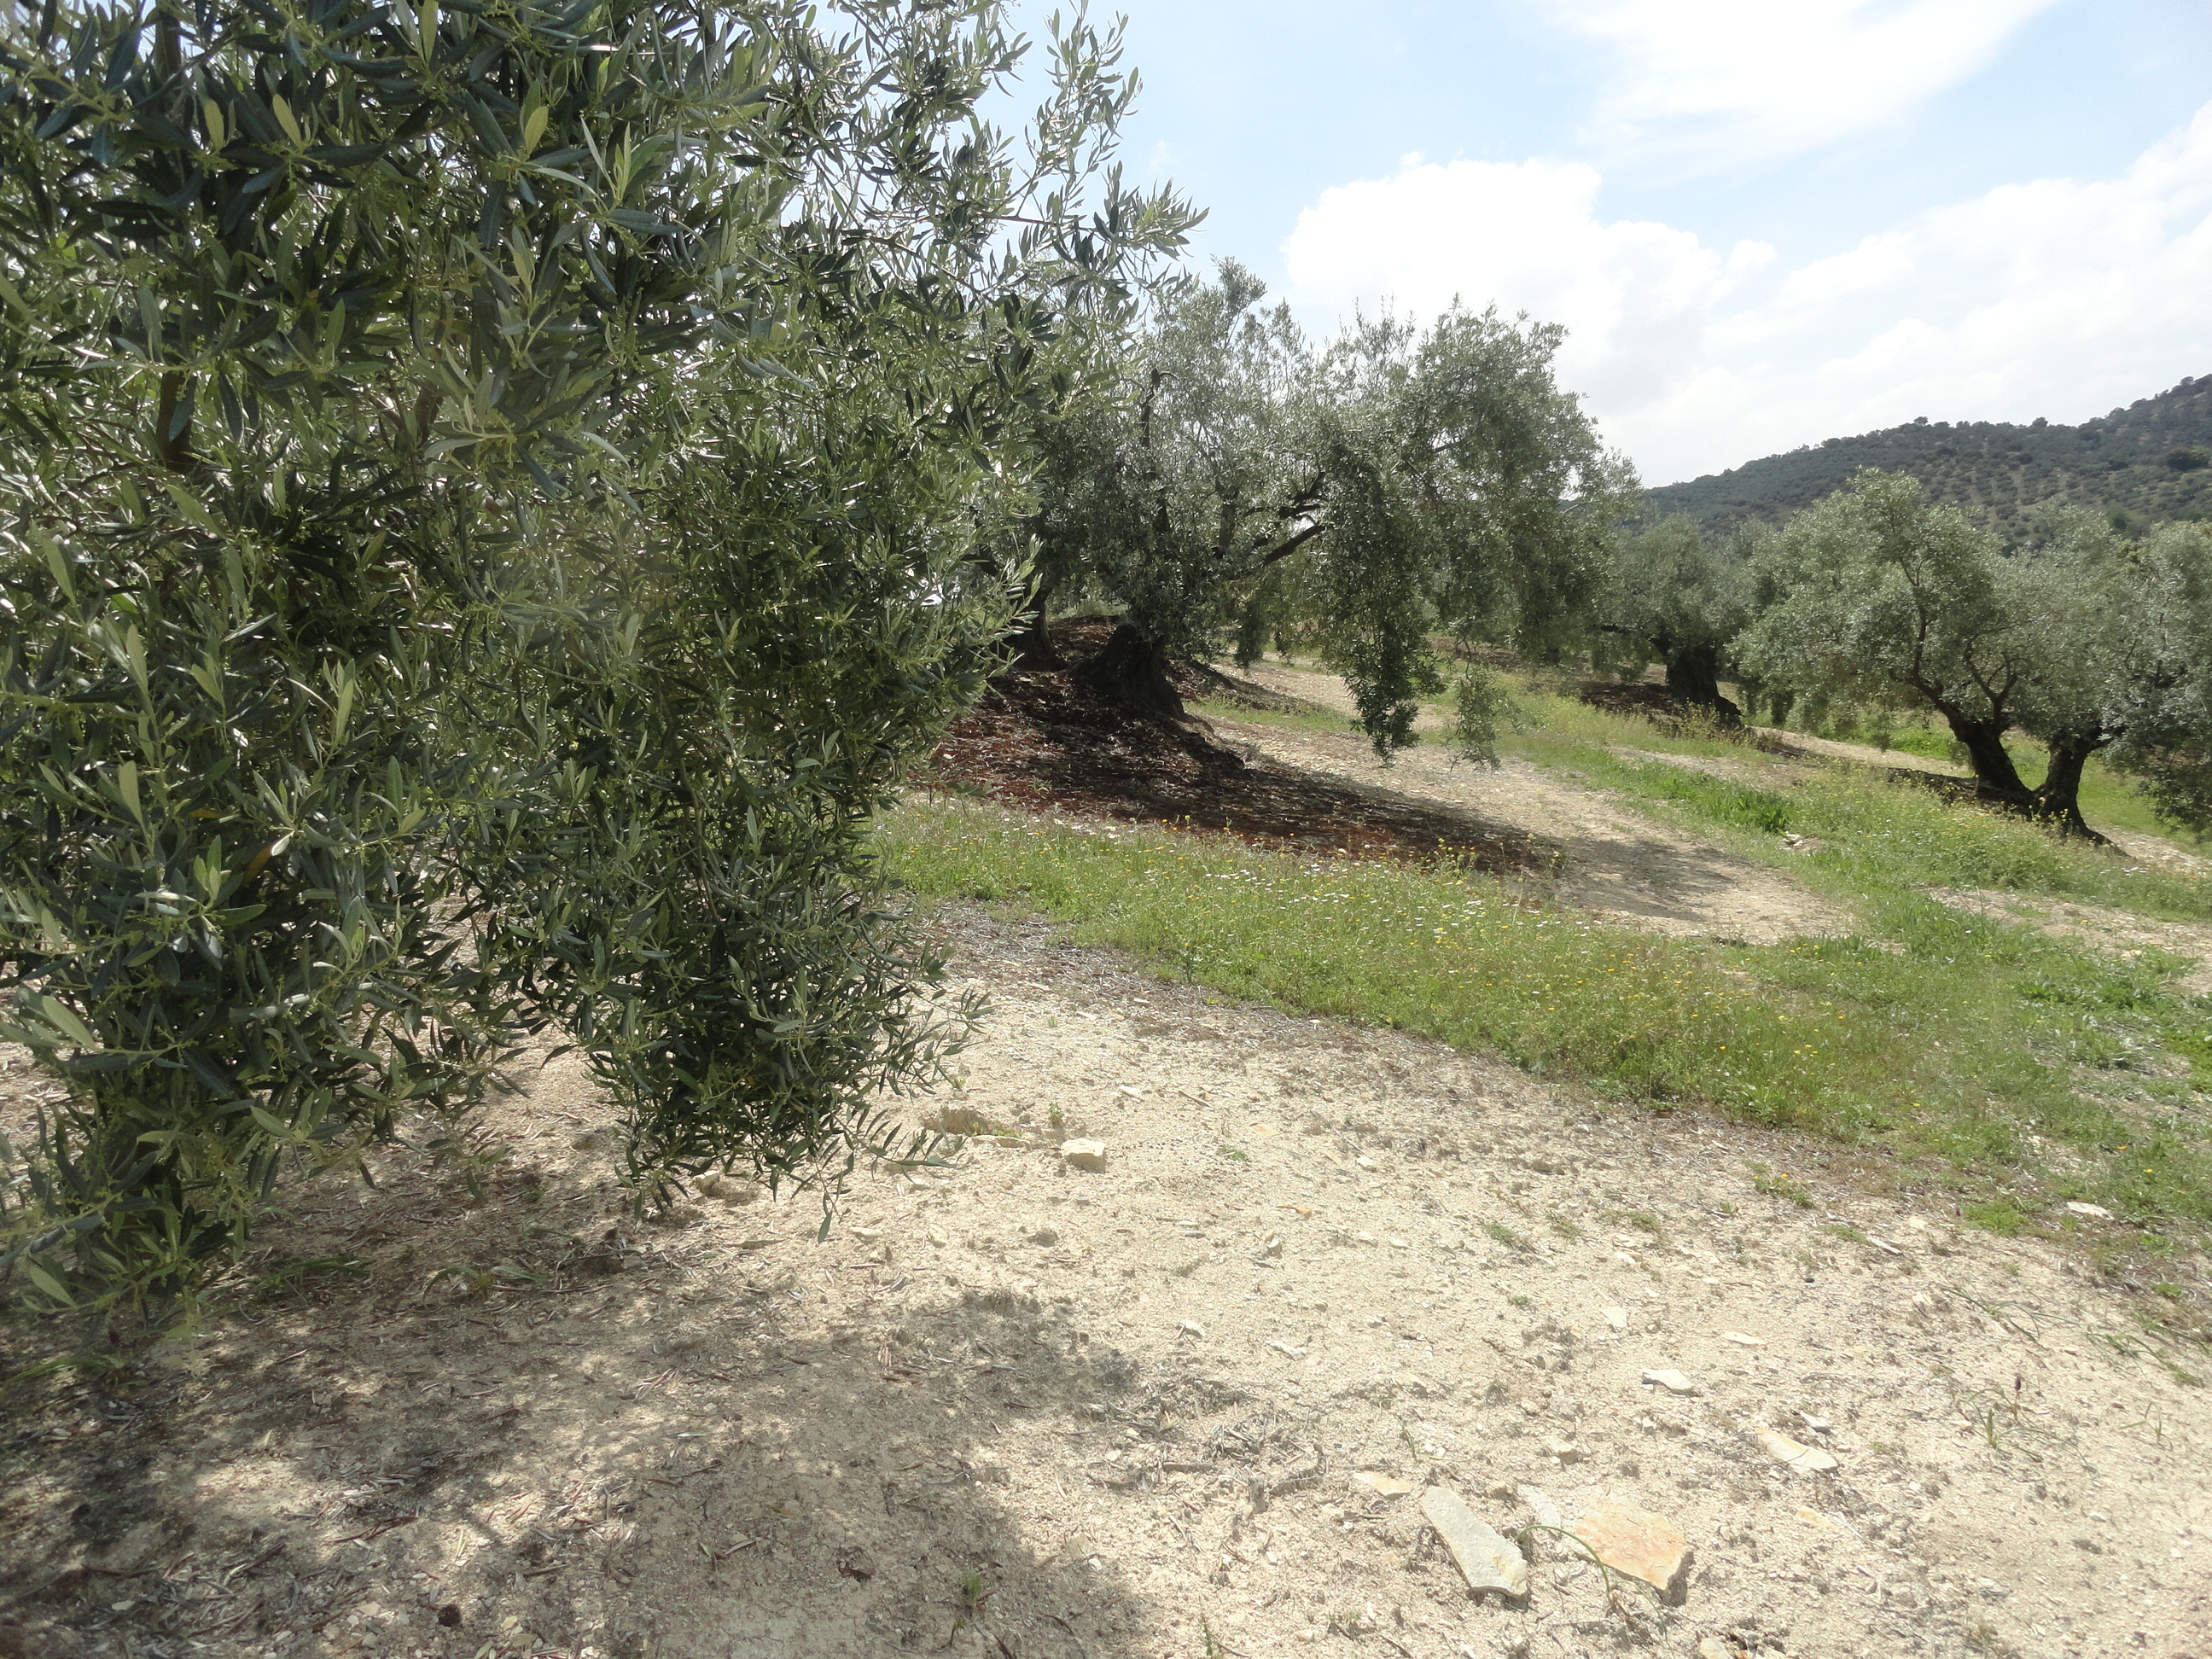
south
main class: Cropland
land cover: Olive groves
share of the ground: 50 - 75 %
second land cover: Spontaneously vegetated surfaces
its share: 10 - 25 %
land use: Agriculture (excluding fallow land and kitchen gardens)
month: April
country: ES
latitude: 37.5628
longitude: -4.5306
